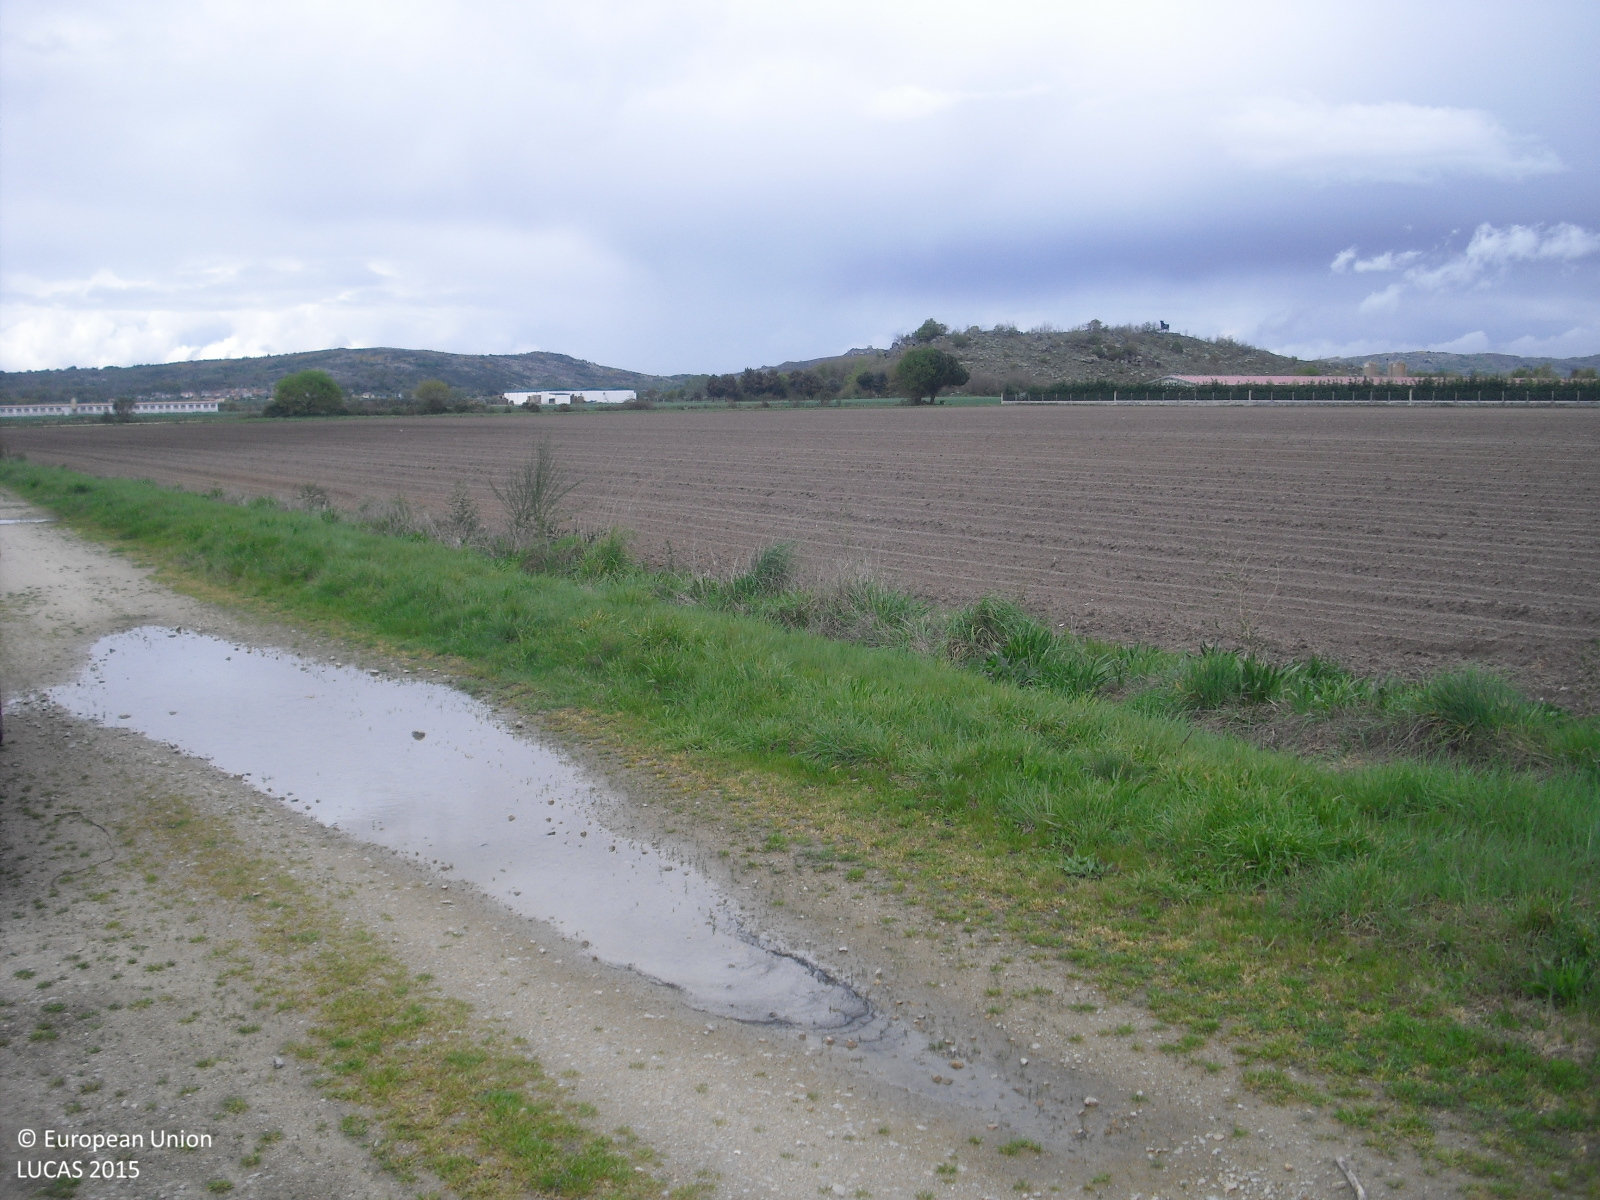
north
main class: Artificial land
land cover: Non built-up linear features
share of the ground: > 75 %
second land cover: Spontaneously vegetated surfaces
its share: 25 - 50 %
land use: Road transport
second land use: Agriculture (excluding fallow land and kitchen gardens)
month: April
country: ES
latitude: 42.0449
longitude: -7.6701
